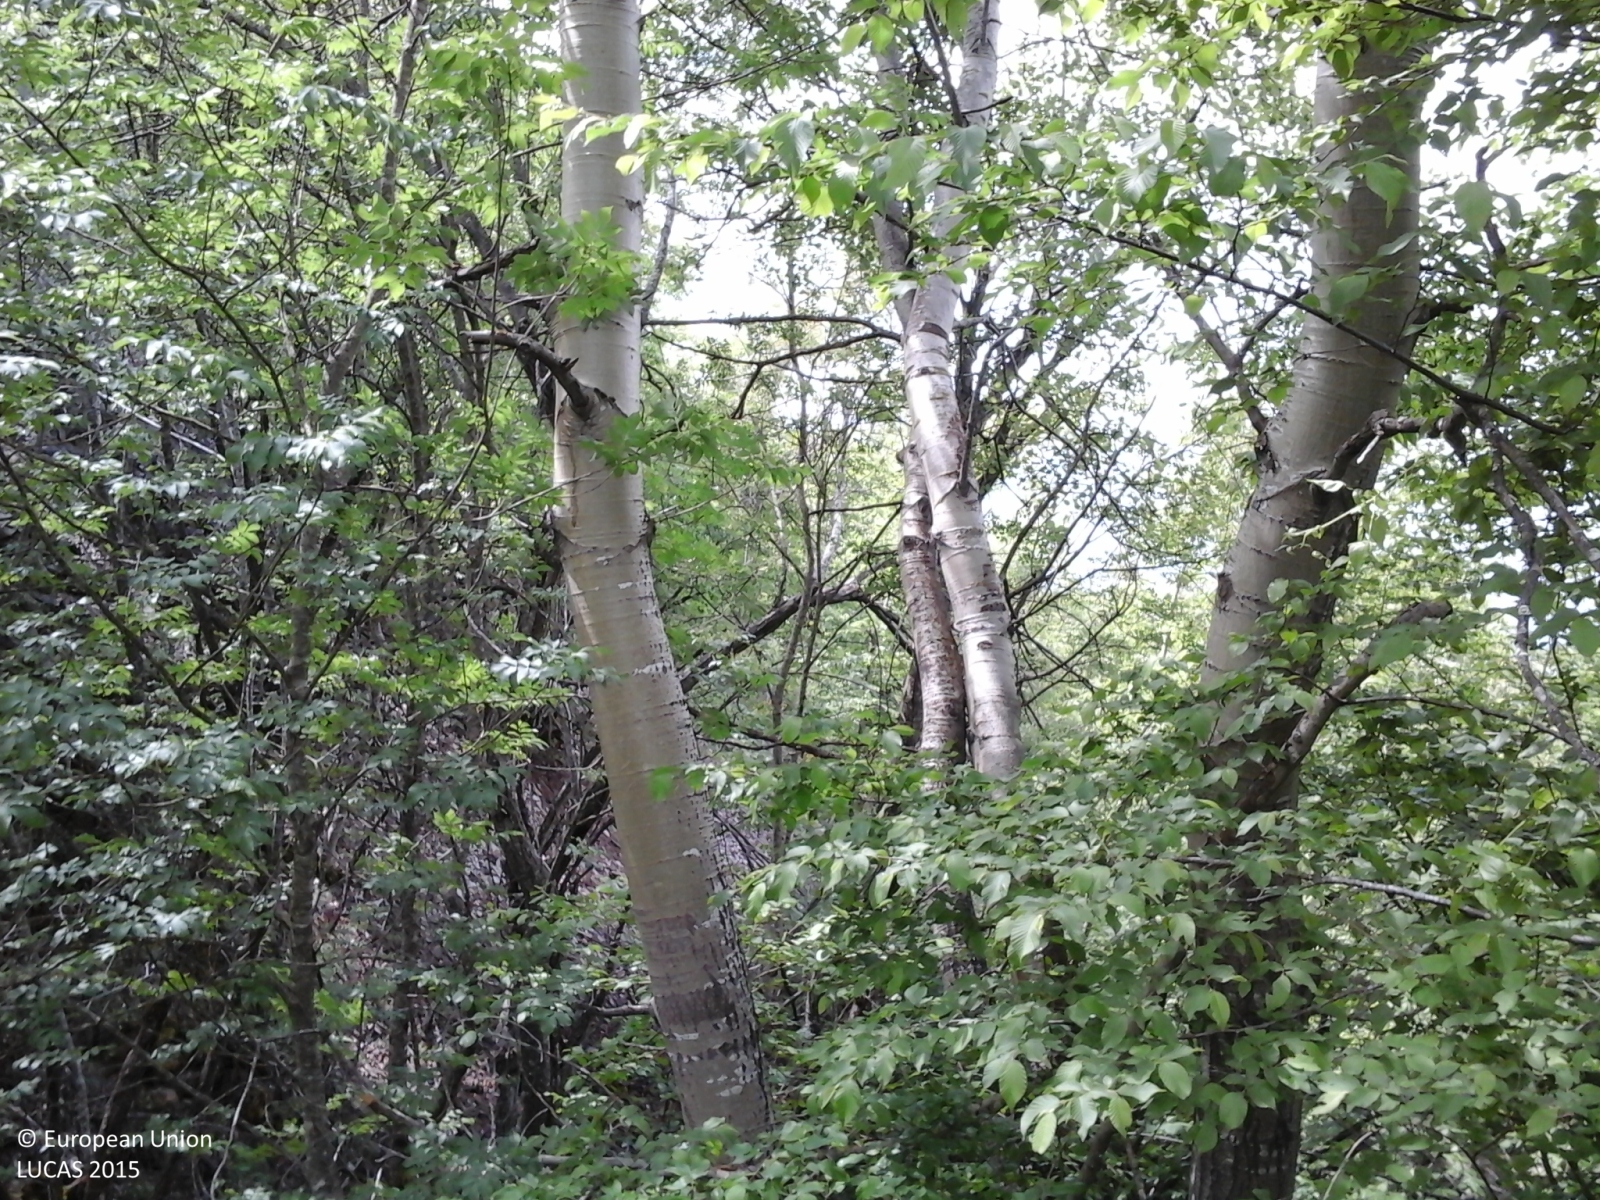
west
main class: Woodland
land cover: Broadleaved woodland
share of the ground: > 75 %
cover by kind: broadleaved forest trees 85 %, shrubs 15 %
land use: Forestry
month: May
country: IT
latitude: 44.5127
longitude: 10.1632
